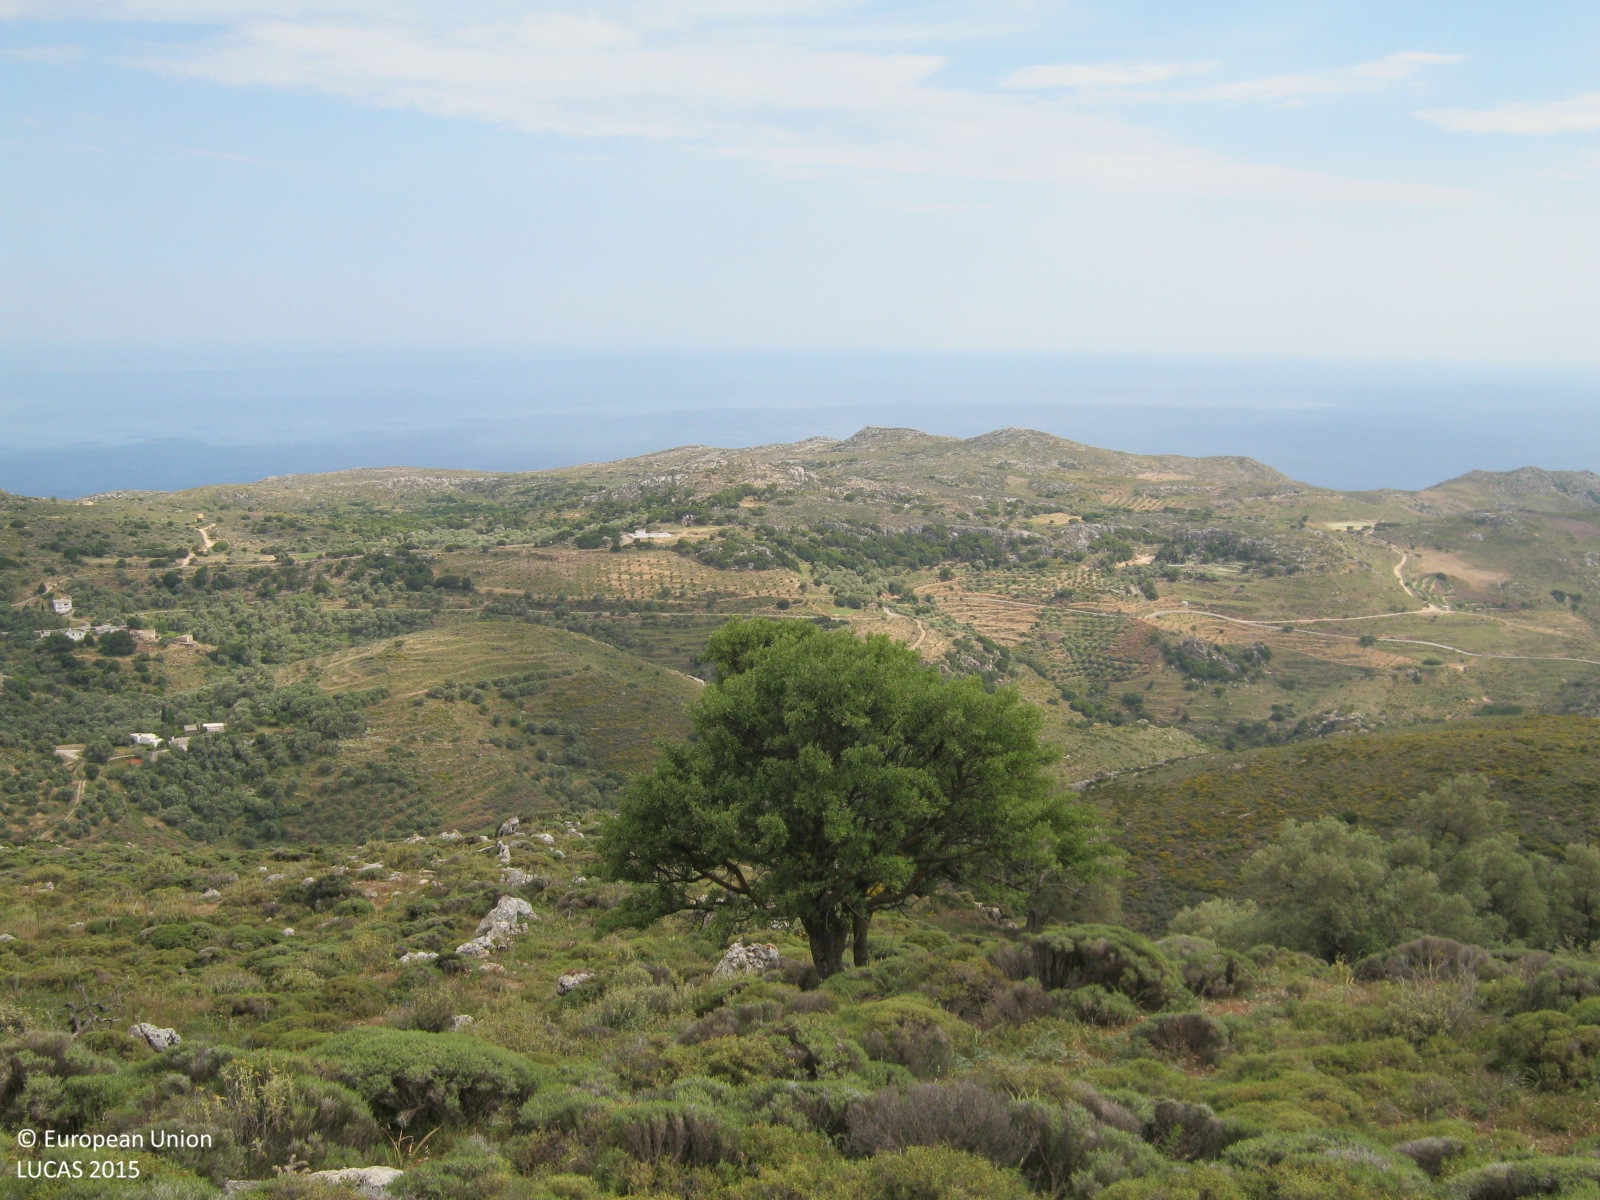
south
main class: Shrubland
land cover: Shrubland with sparse tree cover
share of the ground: > 75 %
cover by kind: shrubs 70 %, unconsolidated bare surface 20 %, broadleaved forest trees 5 %, herbaceous plants 5 %
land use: Agriculture (excluding fallow land and kitchen gardens)
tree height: < 5 m
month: June
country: GR
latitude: 35.2721
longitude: 23.7541
